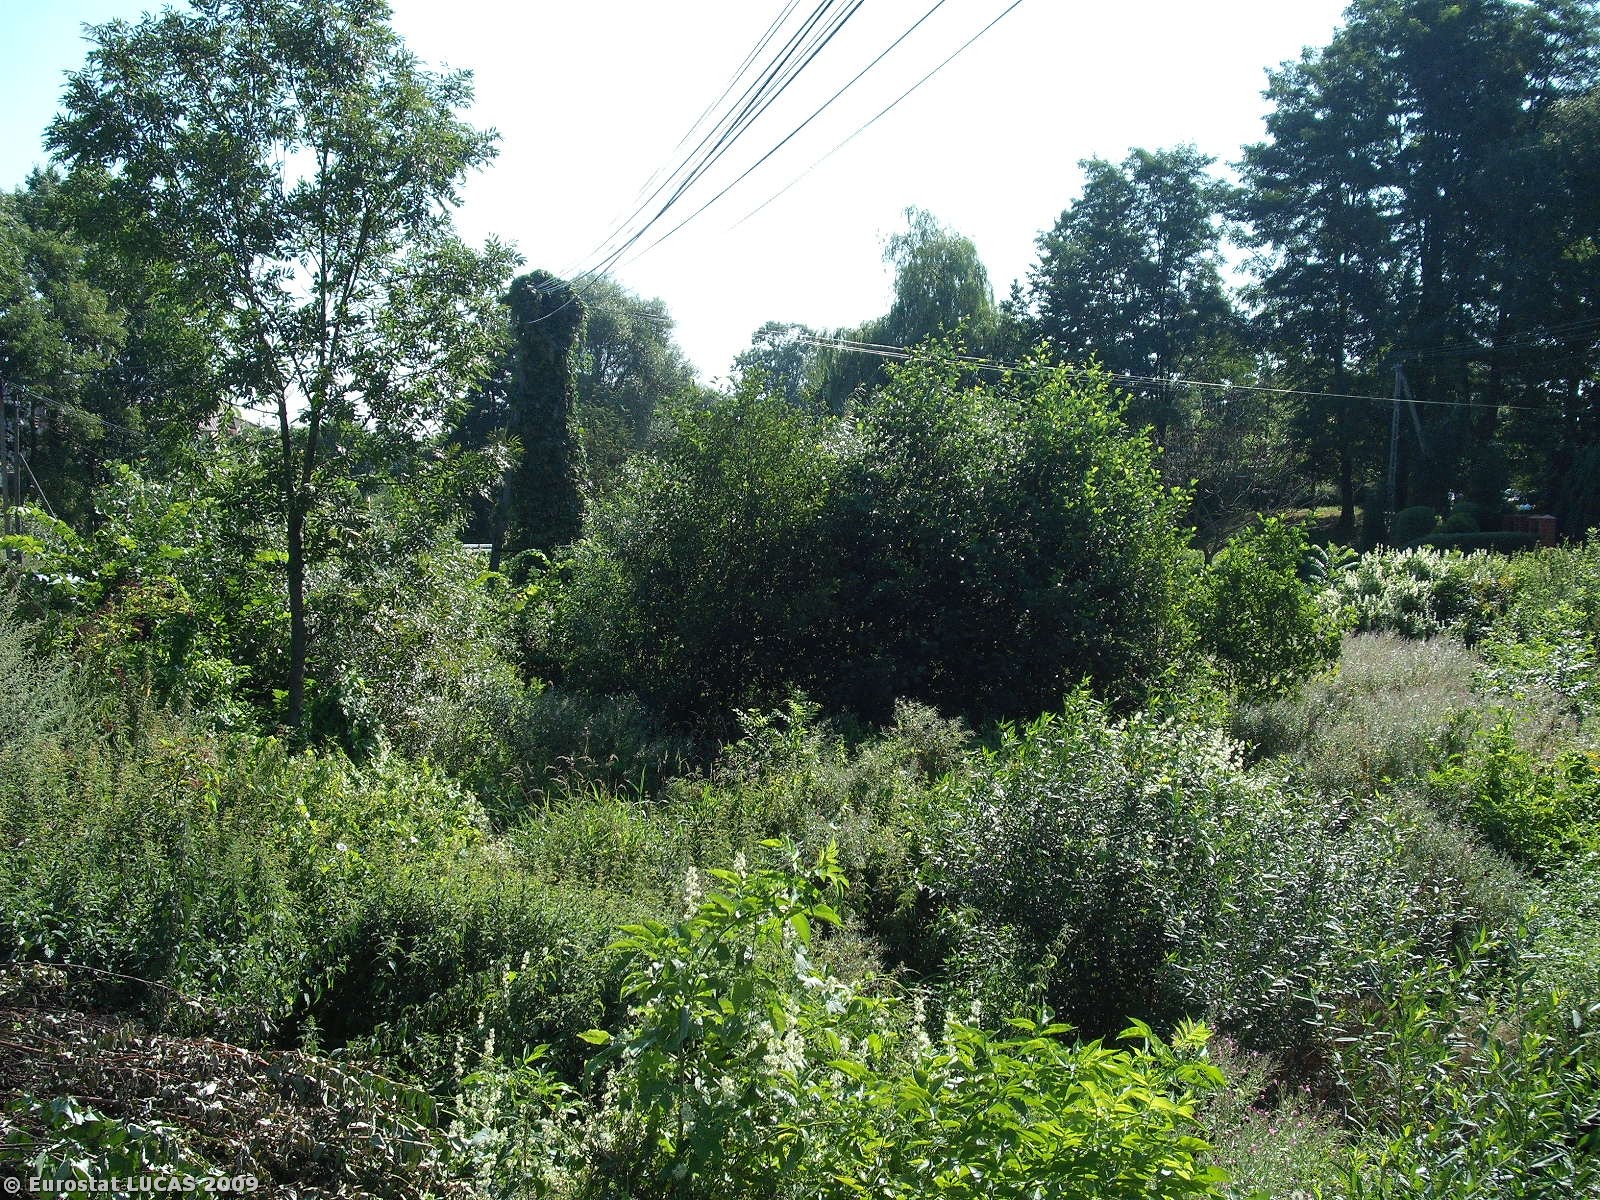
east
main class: Shrubland
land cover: Shrubland with sparse tree cover
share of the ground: > 75 %
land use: Unused
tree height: < 5 m
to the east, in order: Shrubland with sparse tree cover; Electric lines; Shrubland with sparse tree cover; Fences; Artificial constructions in urban areas; Fences; Broadleaved woodland; Grass margins; Paved roads, cycling and walking lanes
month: August
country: PL
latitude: 50.1926
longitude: 22.0913
